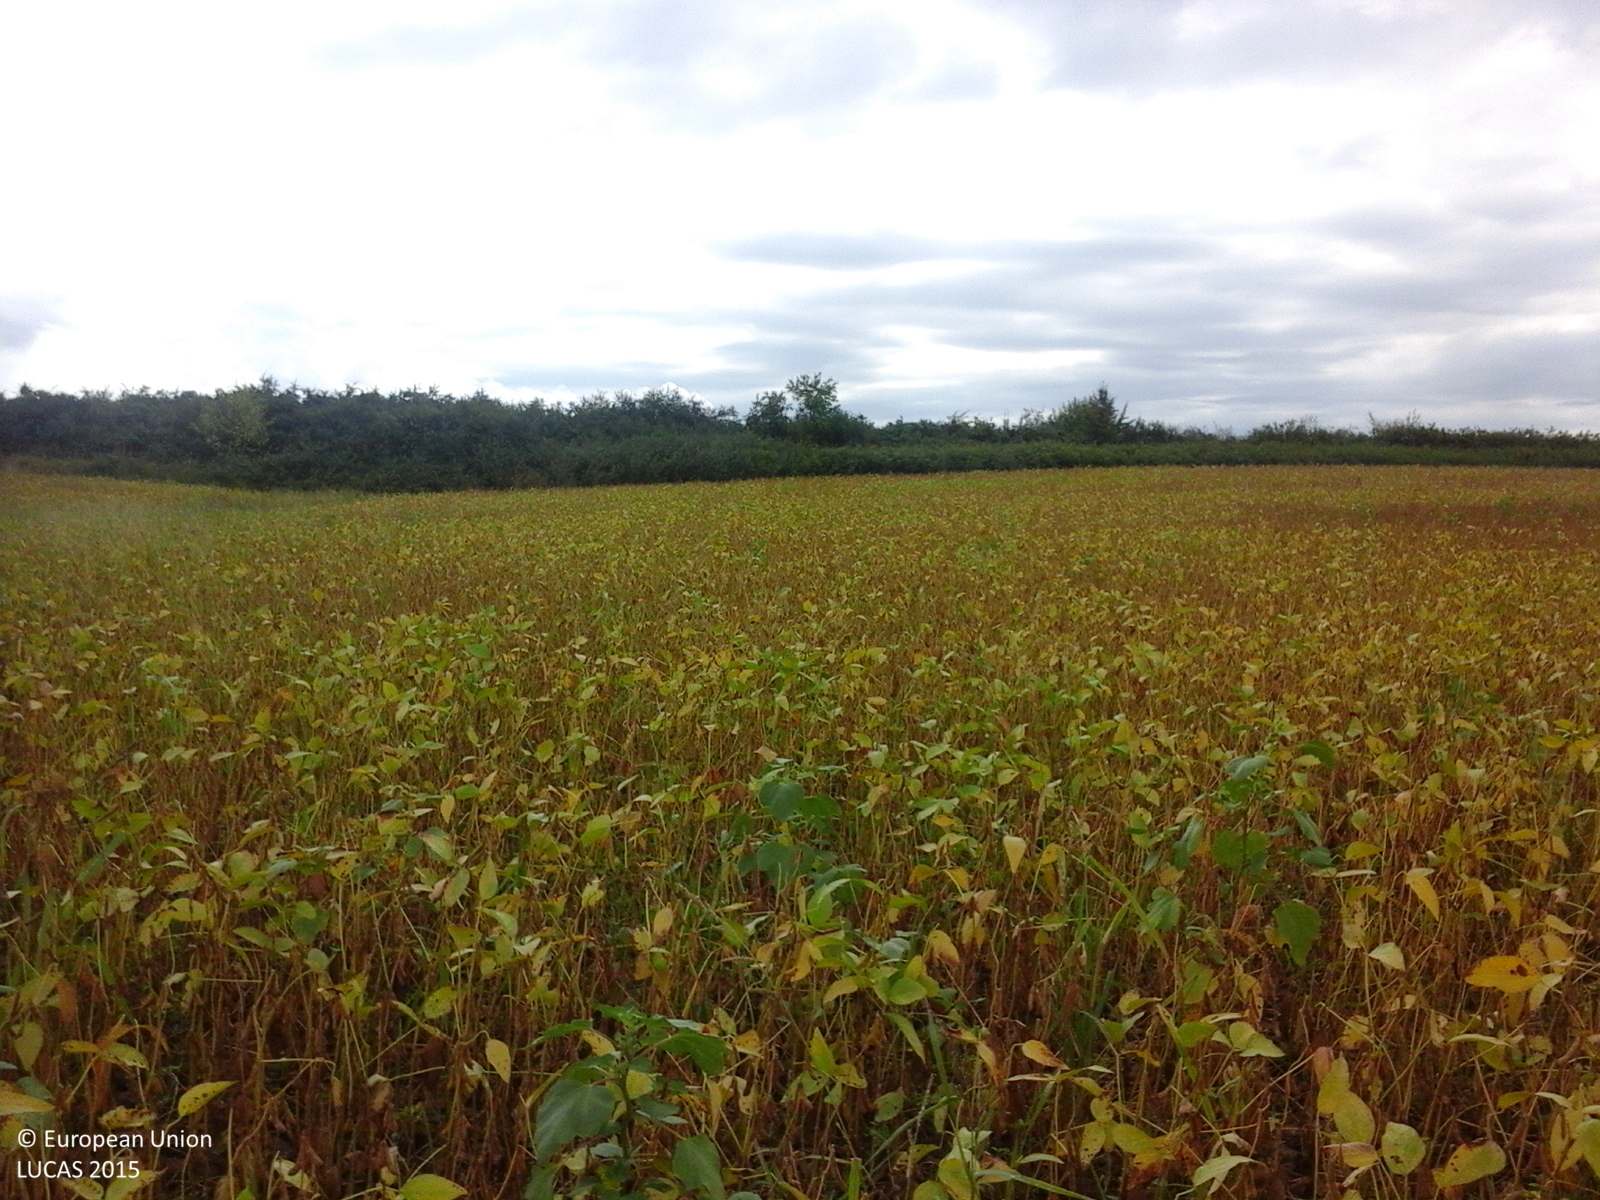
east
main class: Cropland
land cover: Soya
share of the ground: > 75 %
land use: Agriculture (excluding fallow land and kitchen gardens)
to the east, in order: Soya; Shrubland without tree cover; Electric lines; Railways; Electric lines; Shrubland without tree cover; Other bare soil
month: August
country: RO
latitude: 45.5978
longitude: 21.5327
